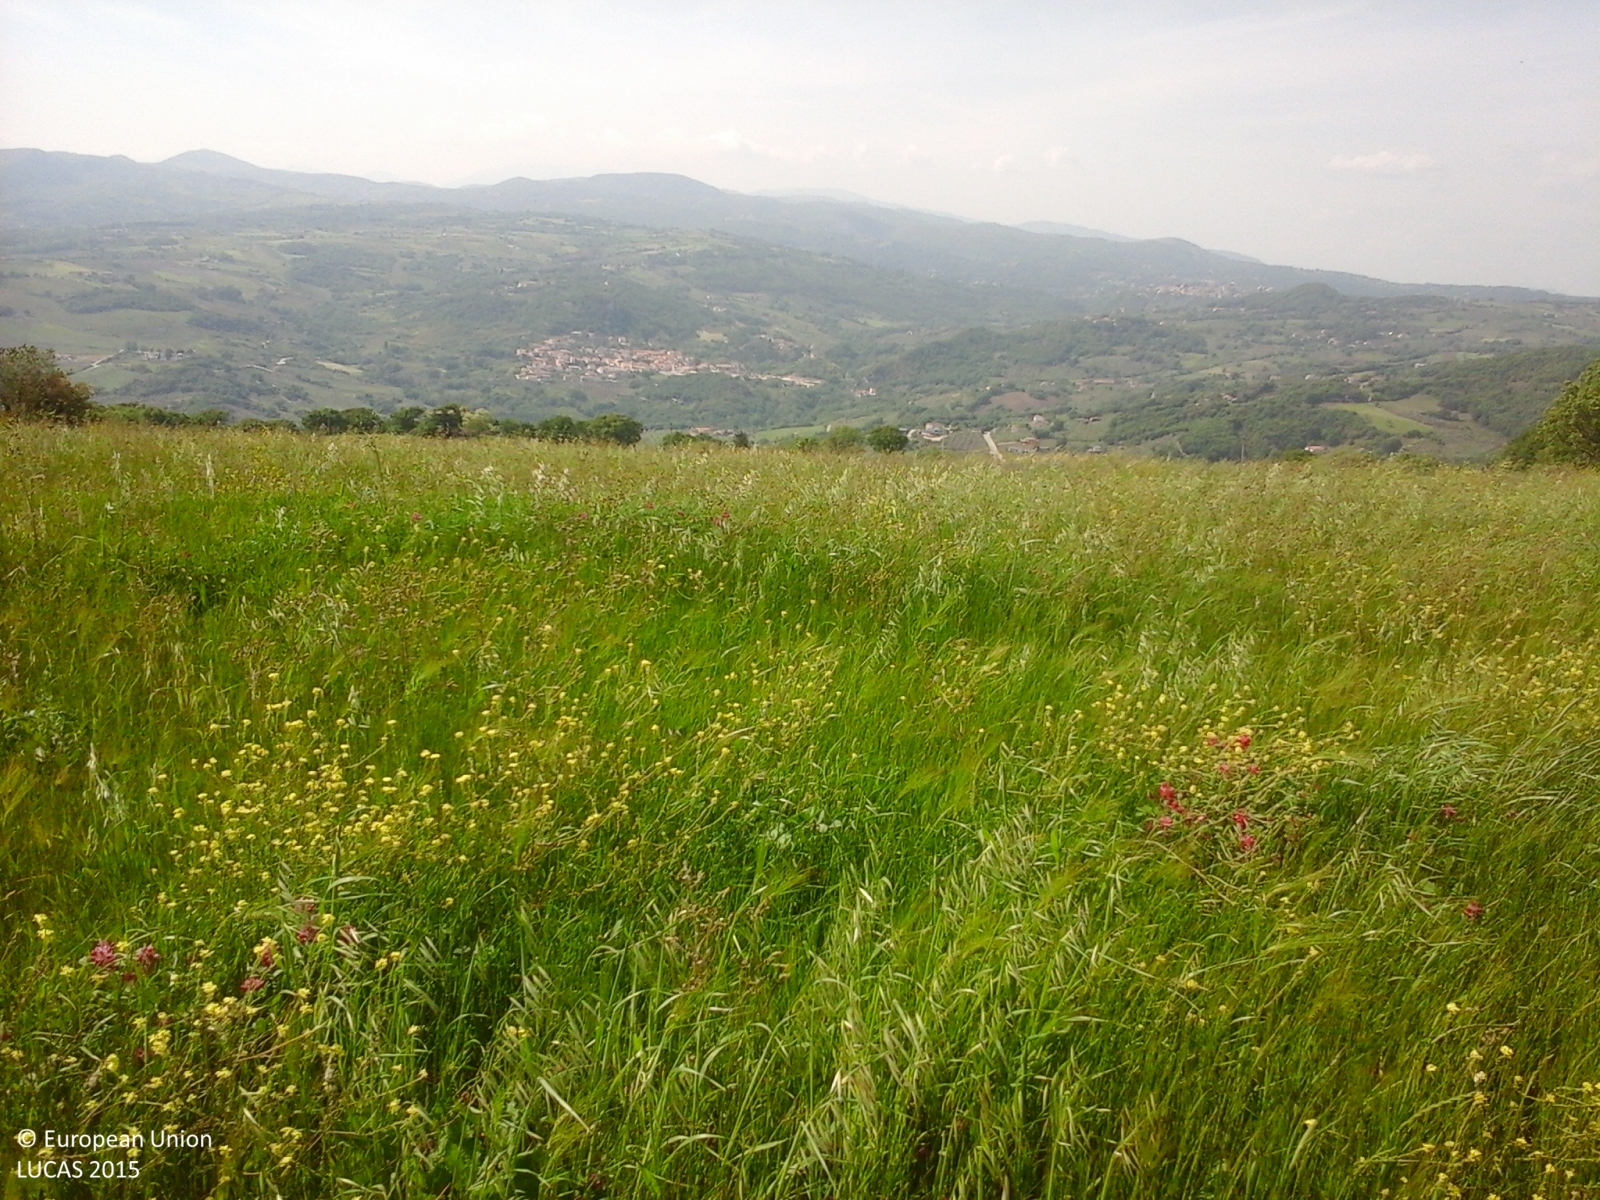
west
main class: Cropland
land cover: Temporary grasslands
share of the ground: > 75 %
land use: Agriculture (excluding fallow land and kitchen gardens)
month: May
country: IT
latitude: 41.2409
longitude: 14.7195
